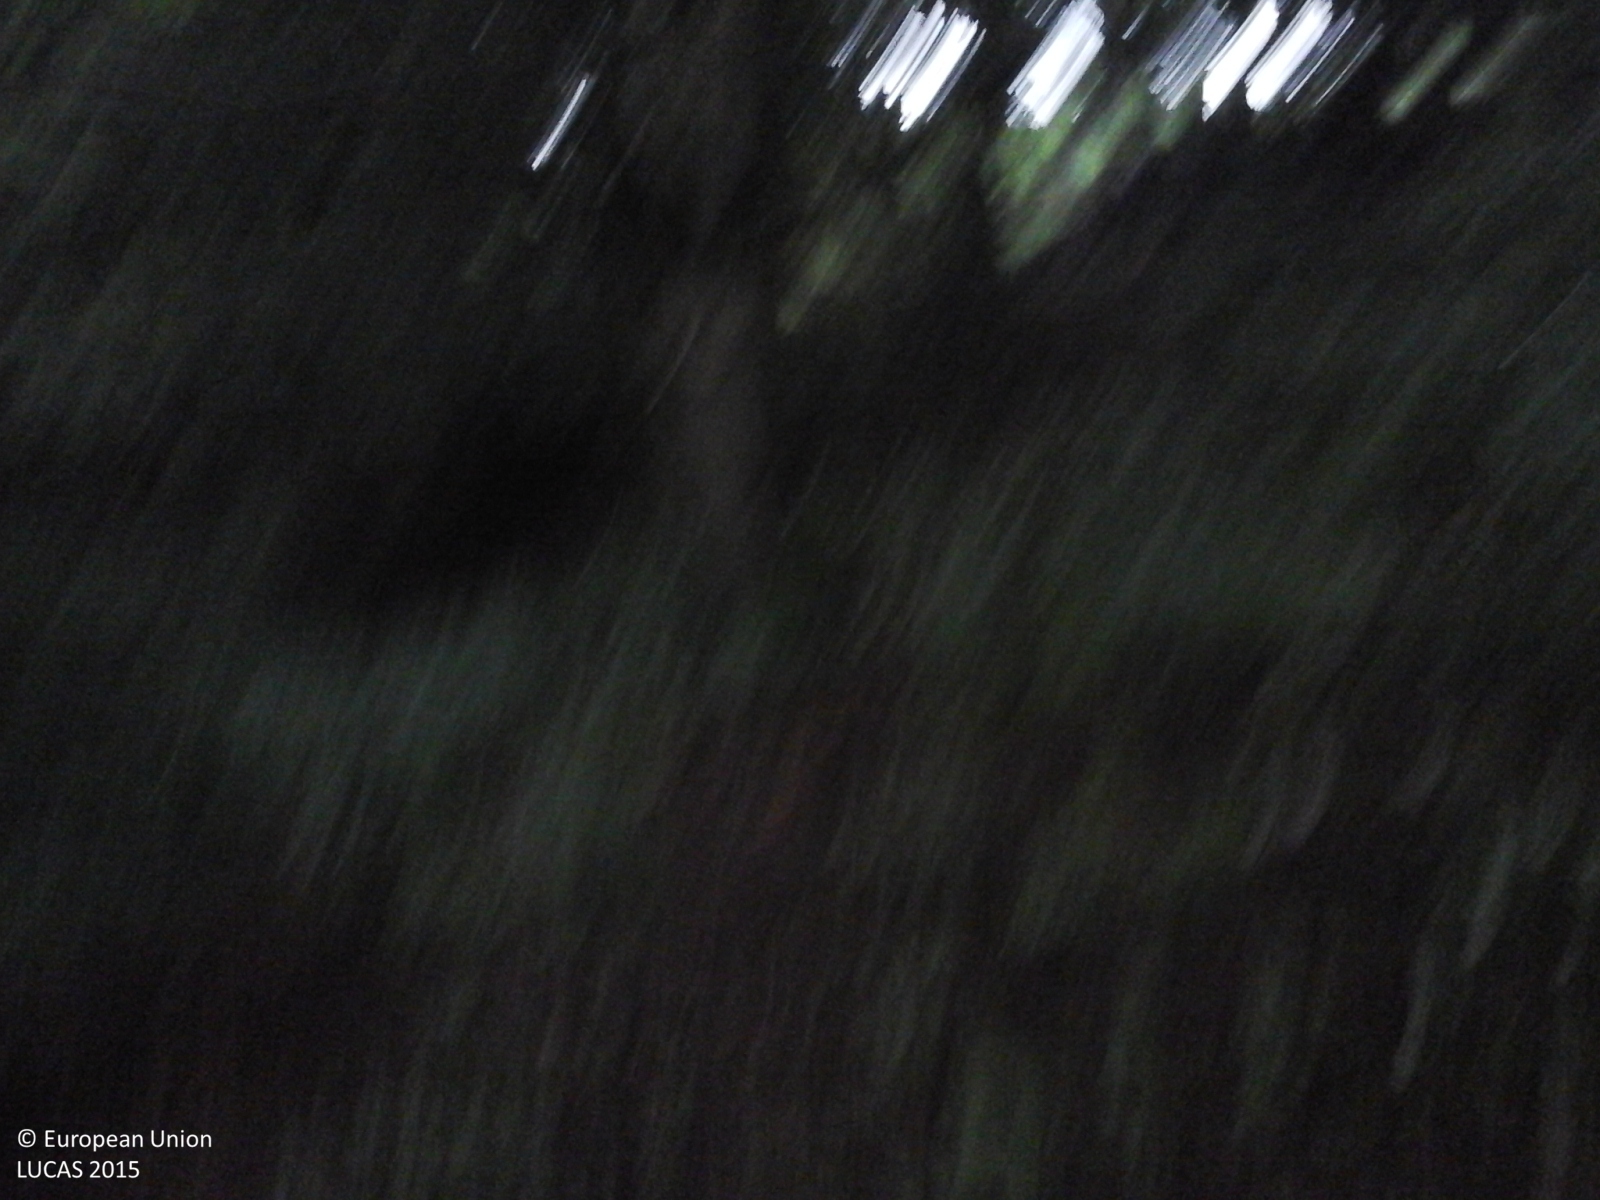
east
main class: Woodland
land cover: Spruce dominated mixed woodland
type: alpine coniferous forest
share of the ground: > 75 %
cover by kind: broadleaved forest trees 75 %, coniferous forest trees 25 %
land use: Semi-natural and natural areas not in use
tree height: > 5 m
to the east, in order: Spruce dominated mixed woodland; Grassland with sparse tree/shrub cover; Managed hedges; Grassland without tree/shrub cover; Artificial constructions in urban areas; Grassland without tree/shrub cover; Tracks; Grassland without tree/shrub cover; Spruce dominated mixed woodland
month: July
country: IT
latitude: 45.9906
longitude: 10.2707
